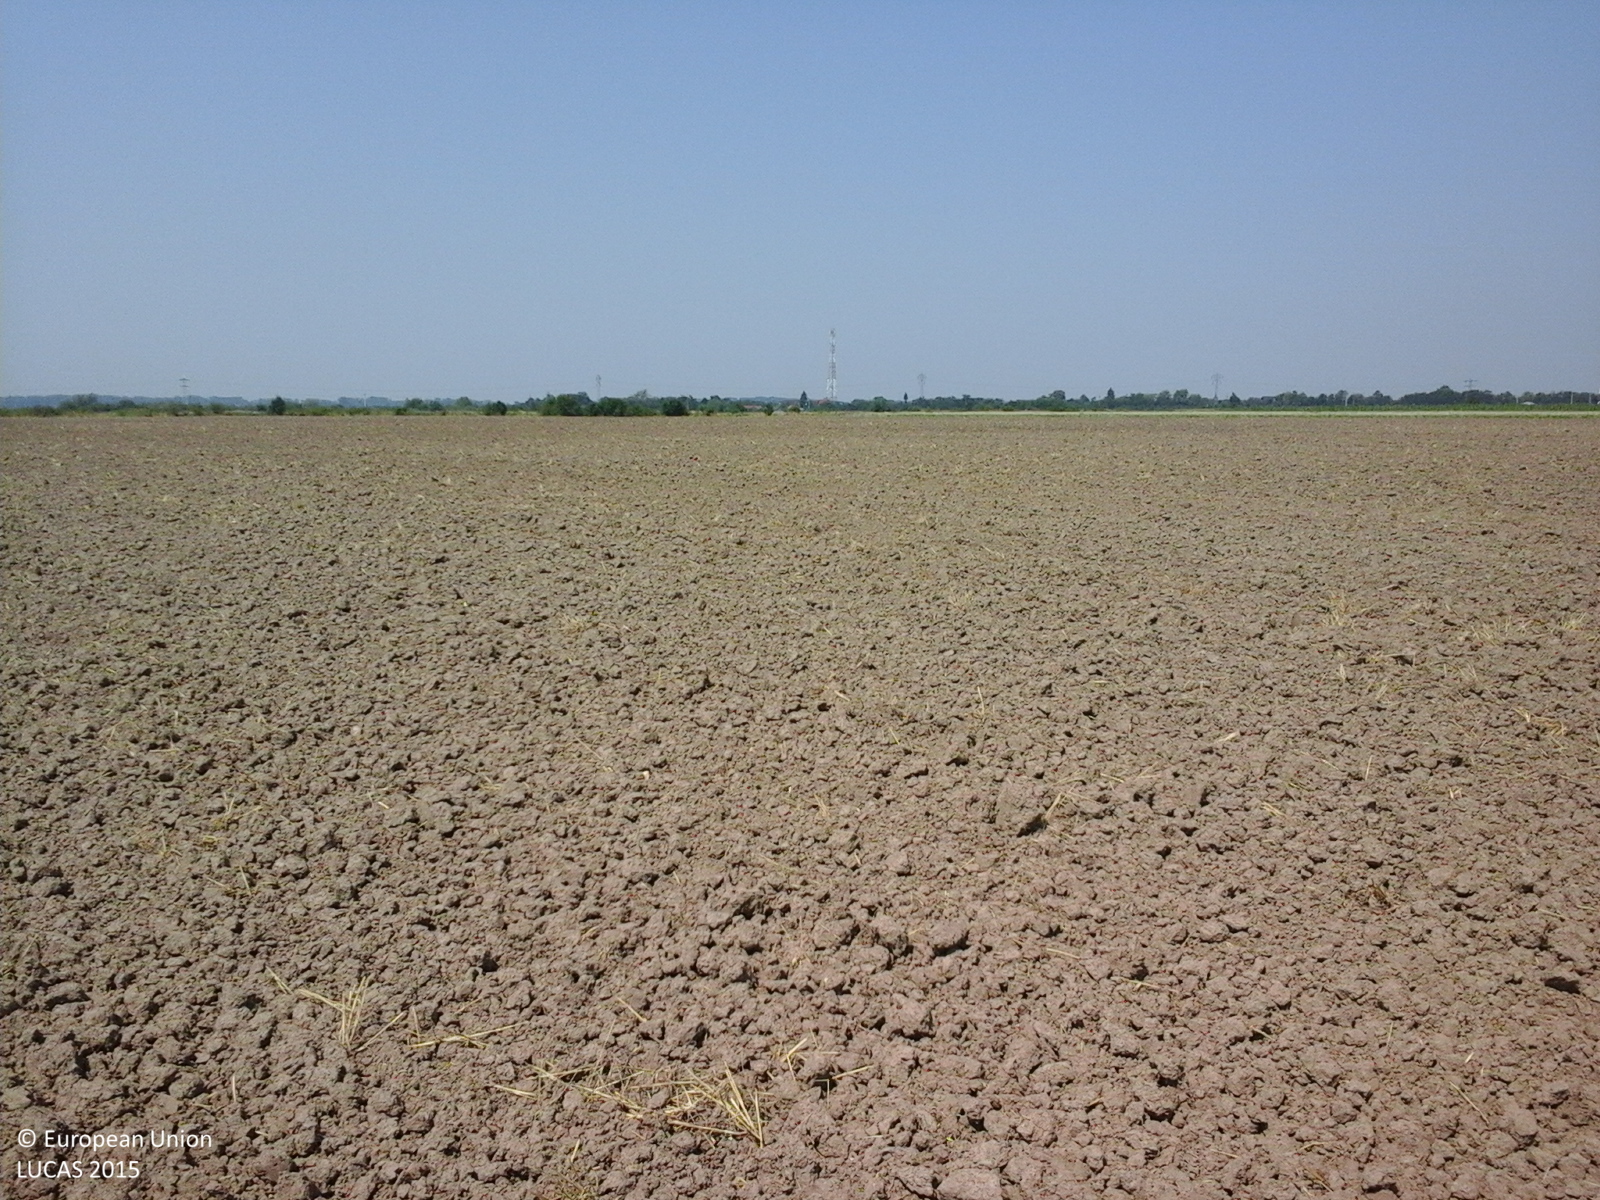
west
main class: Cropland
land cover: Common wheat
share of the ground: < 10 %
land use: Agriculture (excluding fallow land and kitchen gardens)
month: July
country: RO
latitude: 44.7368
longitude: 25.6167
